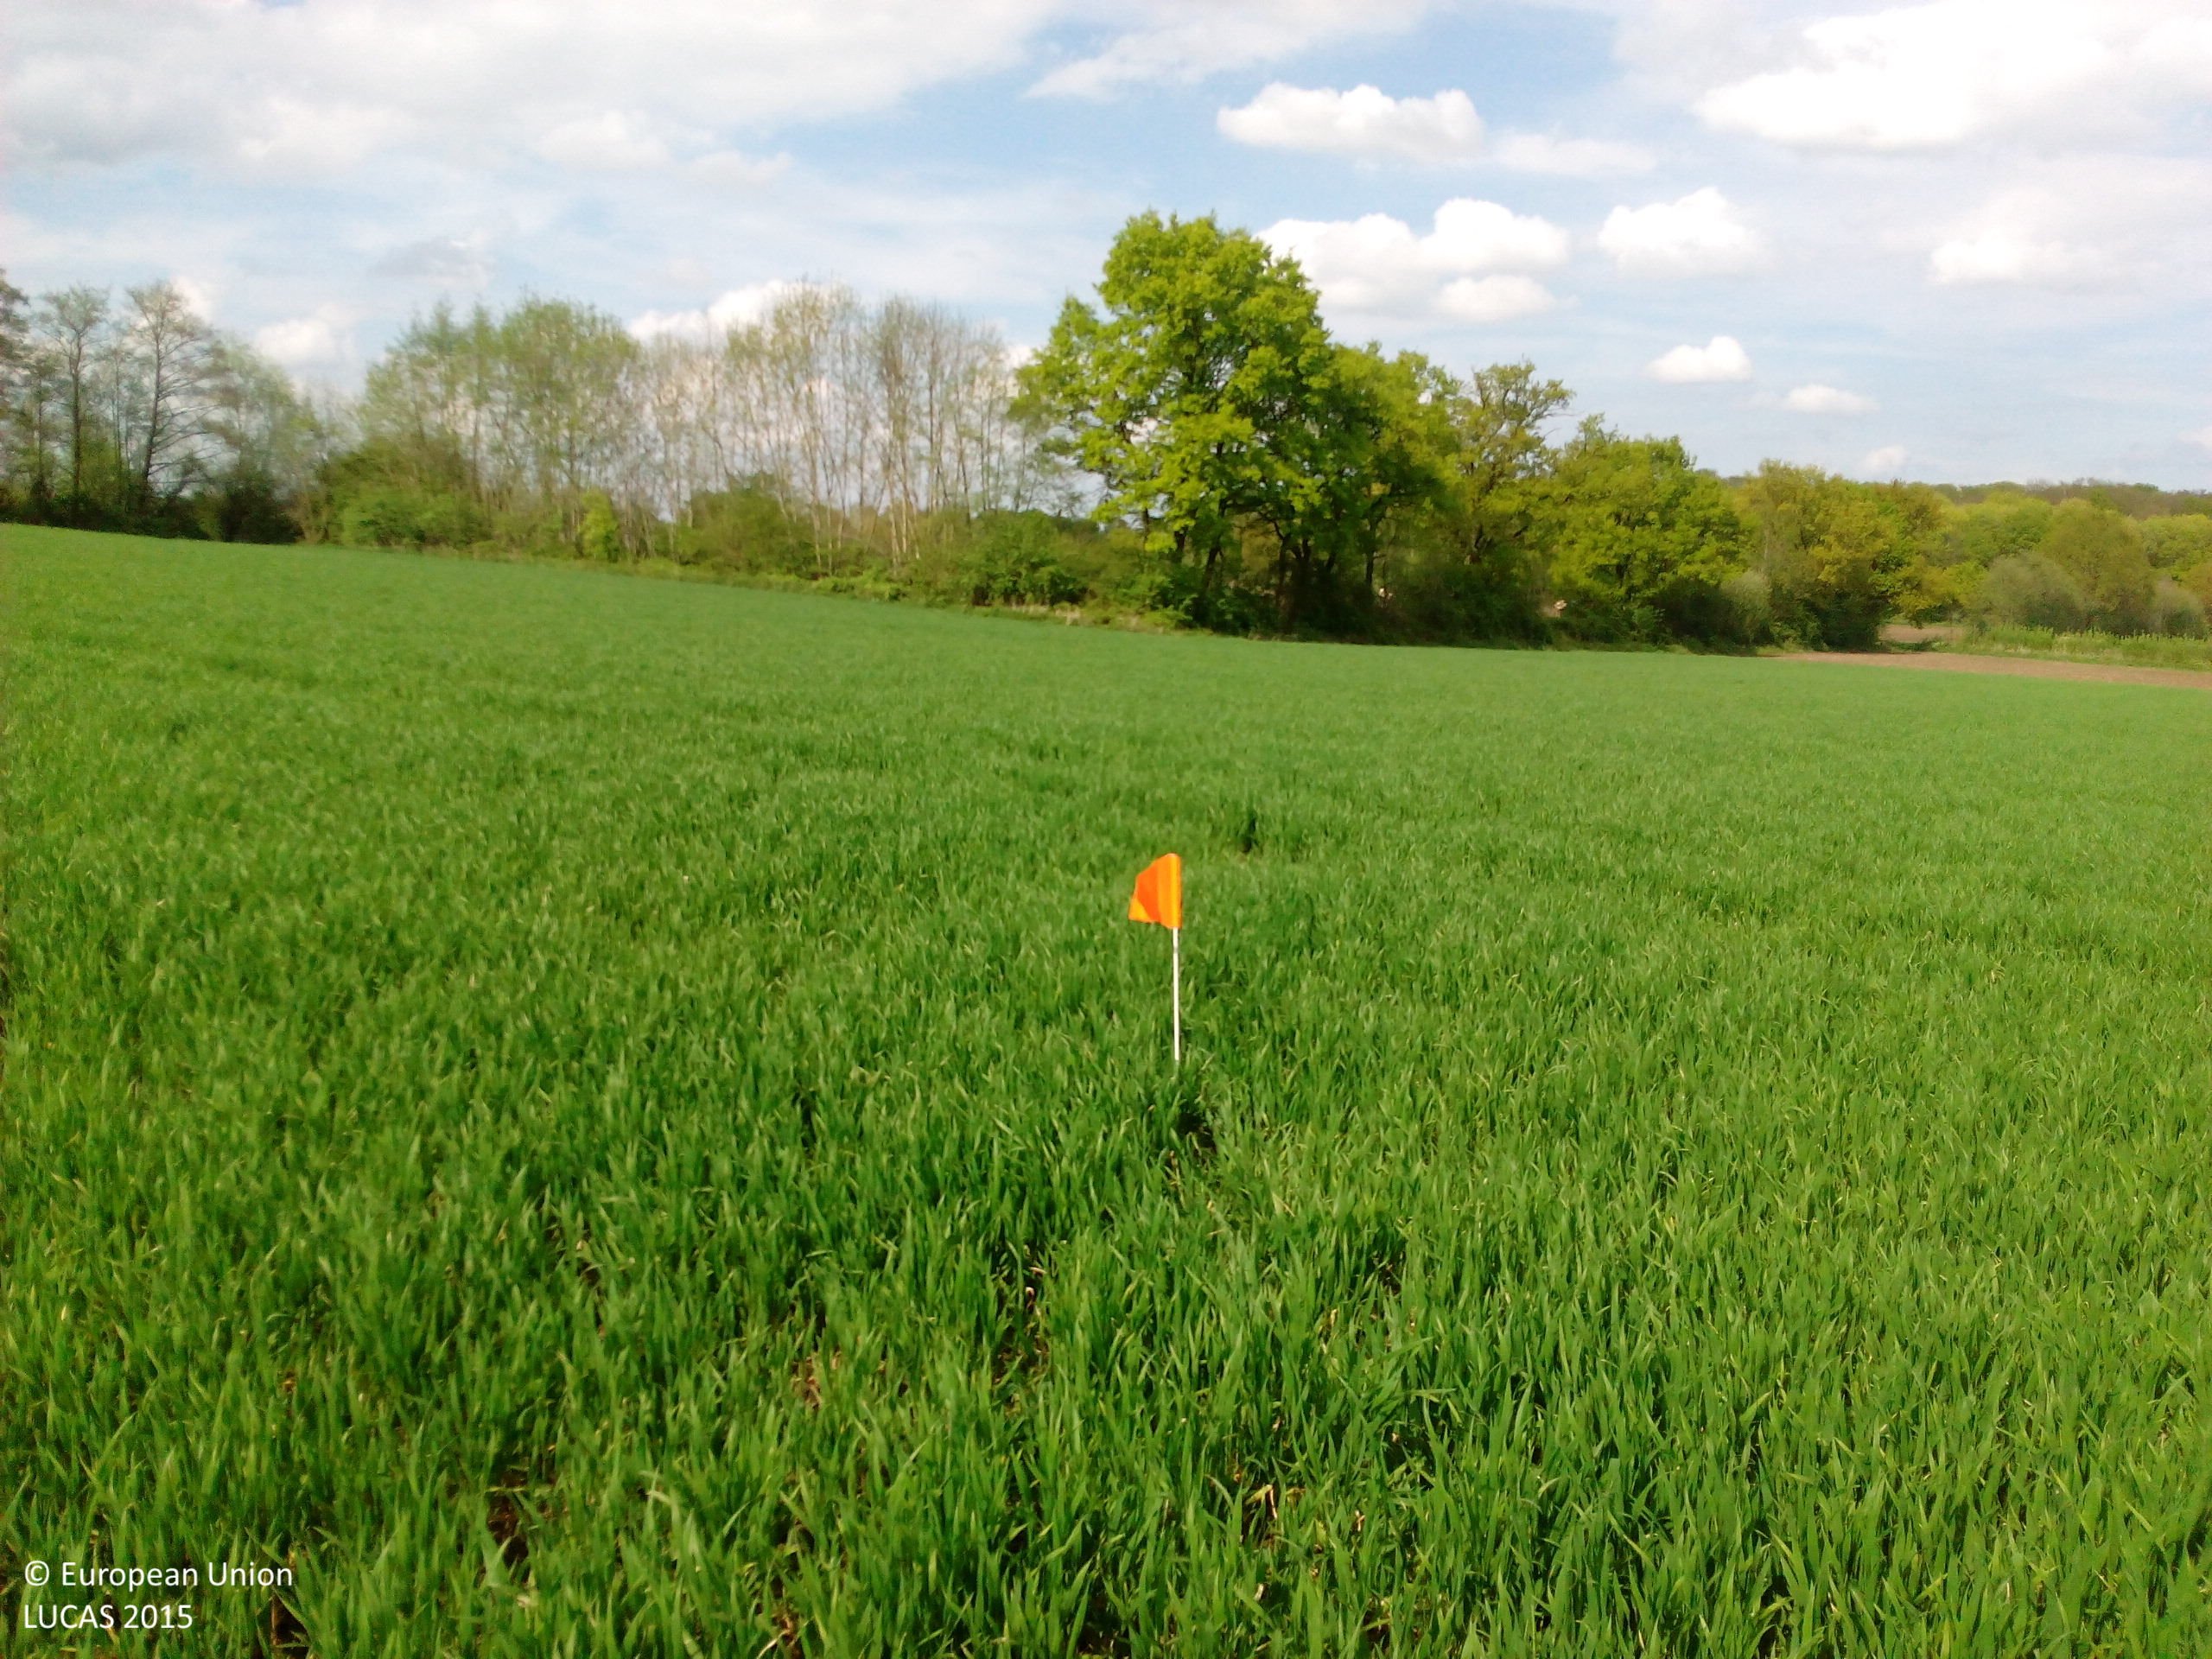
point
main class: Cropland
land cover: Common wheat
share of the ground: 50 - 75 %
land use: Agriculture (excluding fallow land and kitchen gardens)
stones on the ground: < 10 %
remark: Tilled/Sowed
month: May
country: DE
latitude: 51.7557
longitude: 7.4071
